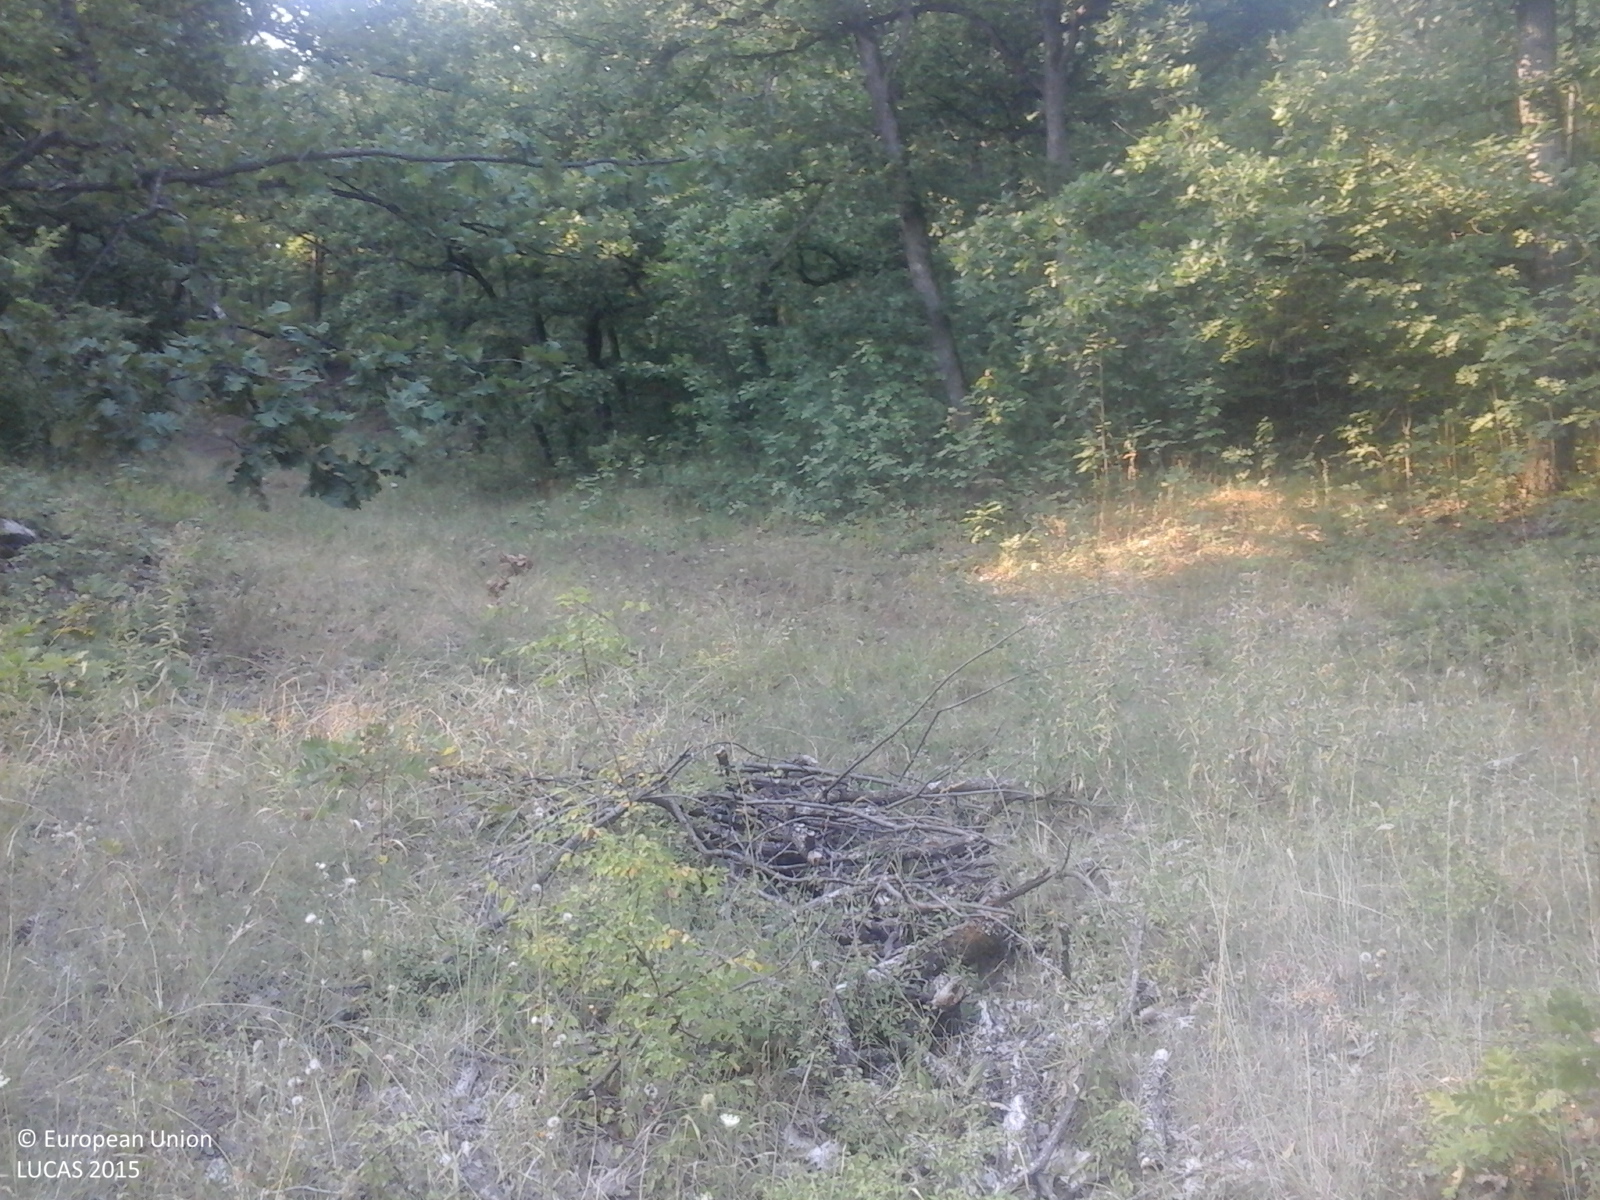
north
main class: Woodland
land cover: Broadleaved woodland
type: acidophilous oak and oak-birch forest
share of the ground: > 75 %
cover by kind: broadleaved forest trees 100 %
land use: Forestry
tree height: > 5 m
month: August
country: RO
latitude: 44.5788
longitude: 23.2100
